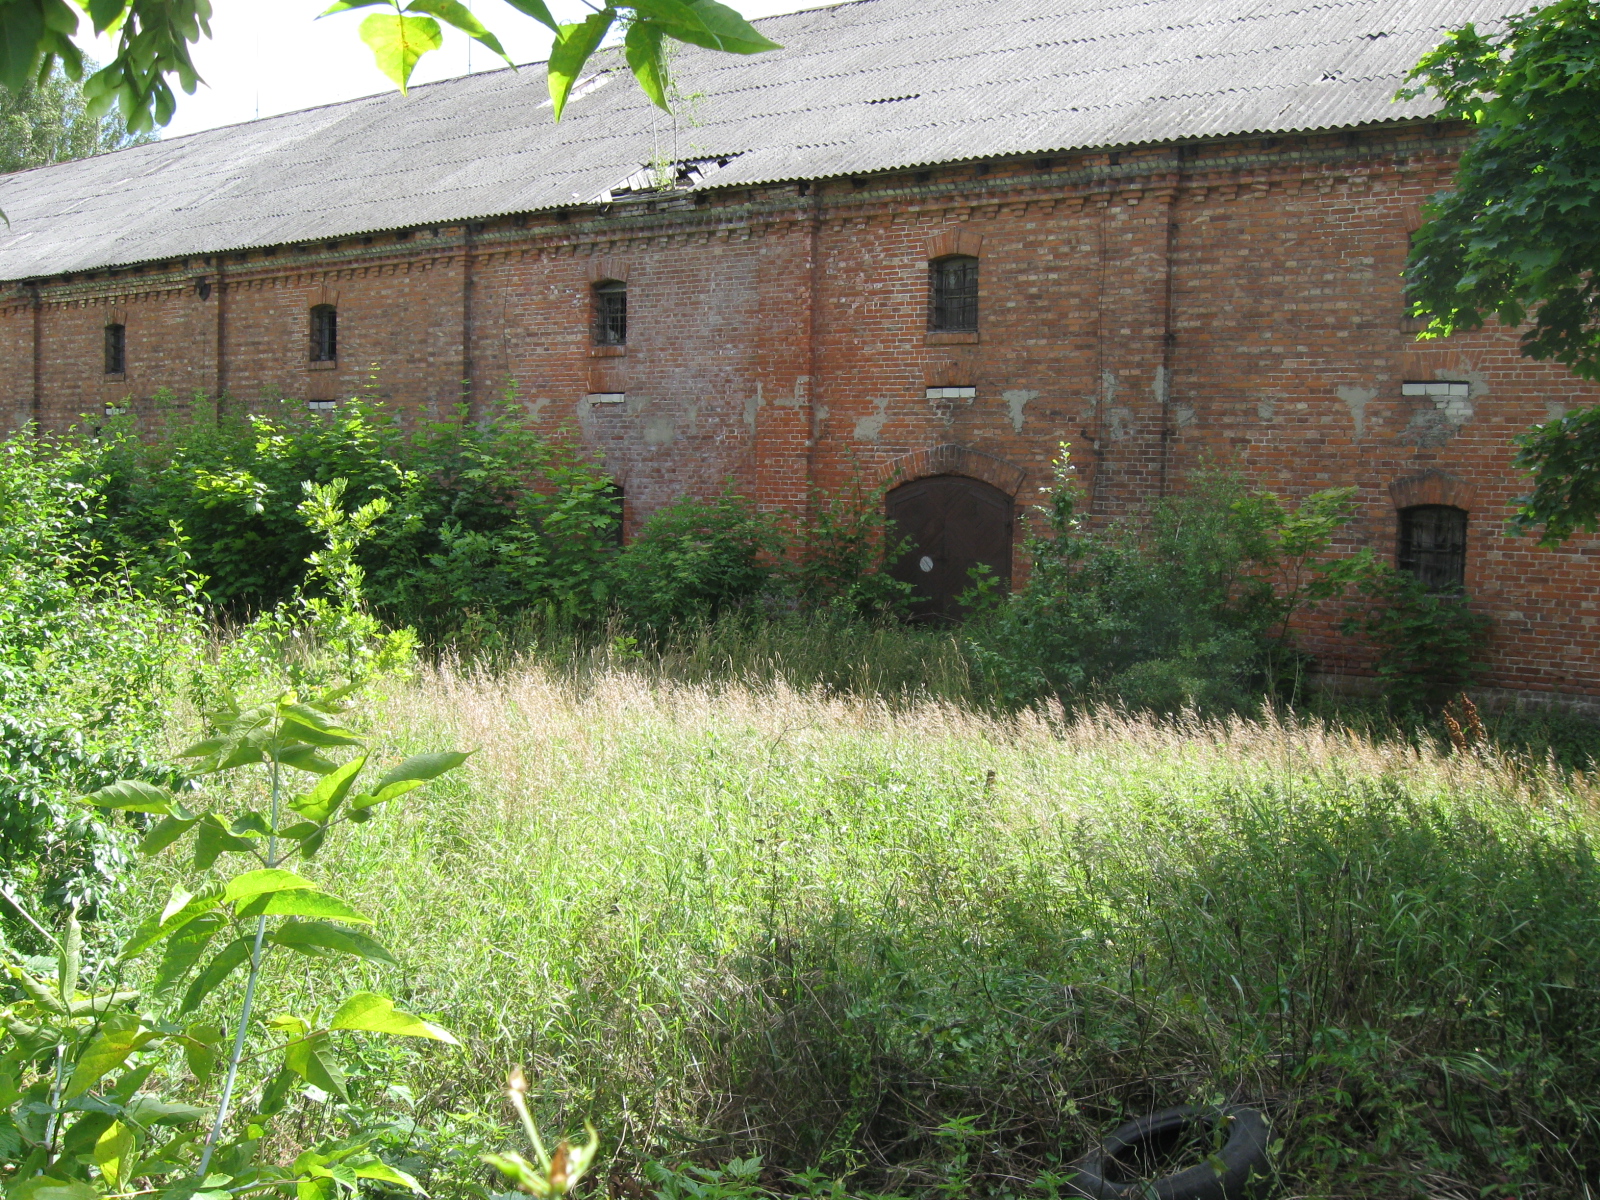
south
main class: Shrubland
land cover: Shrubland with sparse tree cover
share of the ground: > 75 %
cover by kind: herbaceous plants 45 %, shrubs 40 %, unconsolidated bare surface 10 %, broadleaved forest trees 5 %
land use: Semi-natural and natural areas not in use
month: July
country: LT
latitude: 54.8730
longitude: 23.9439
